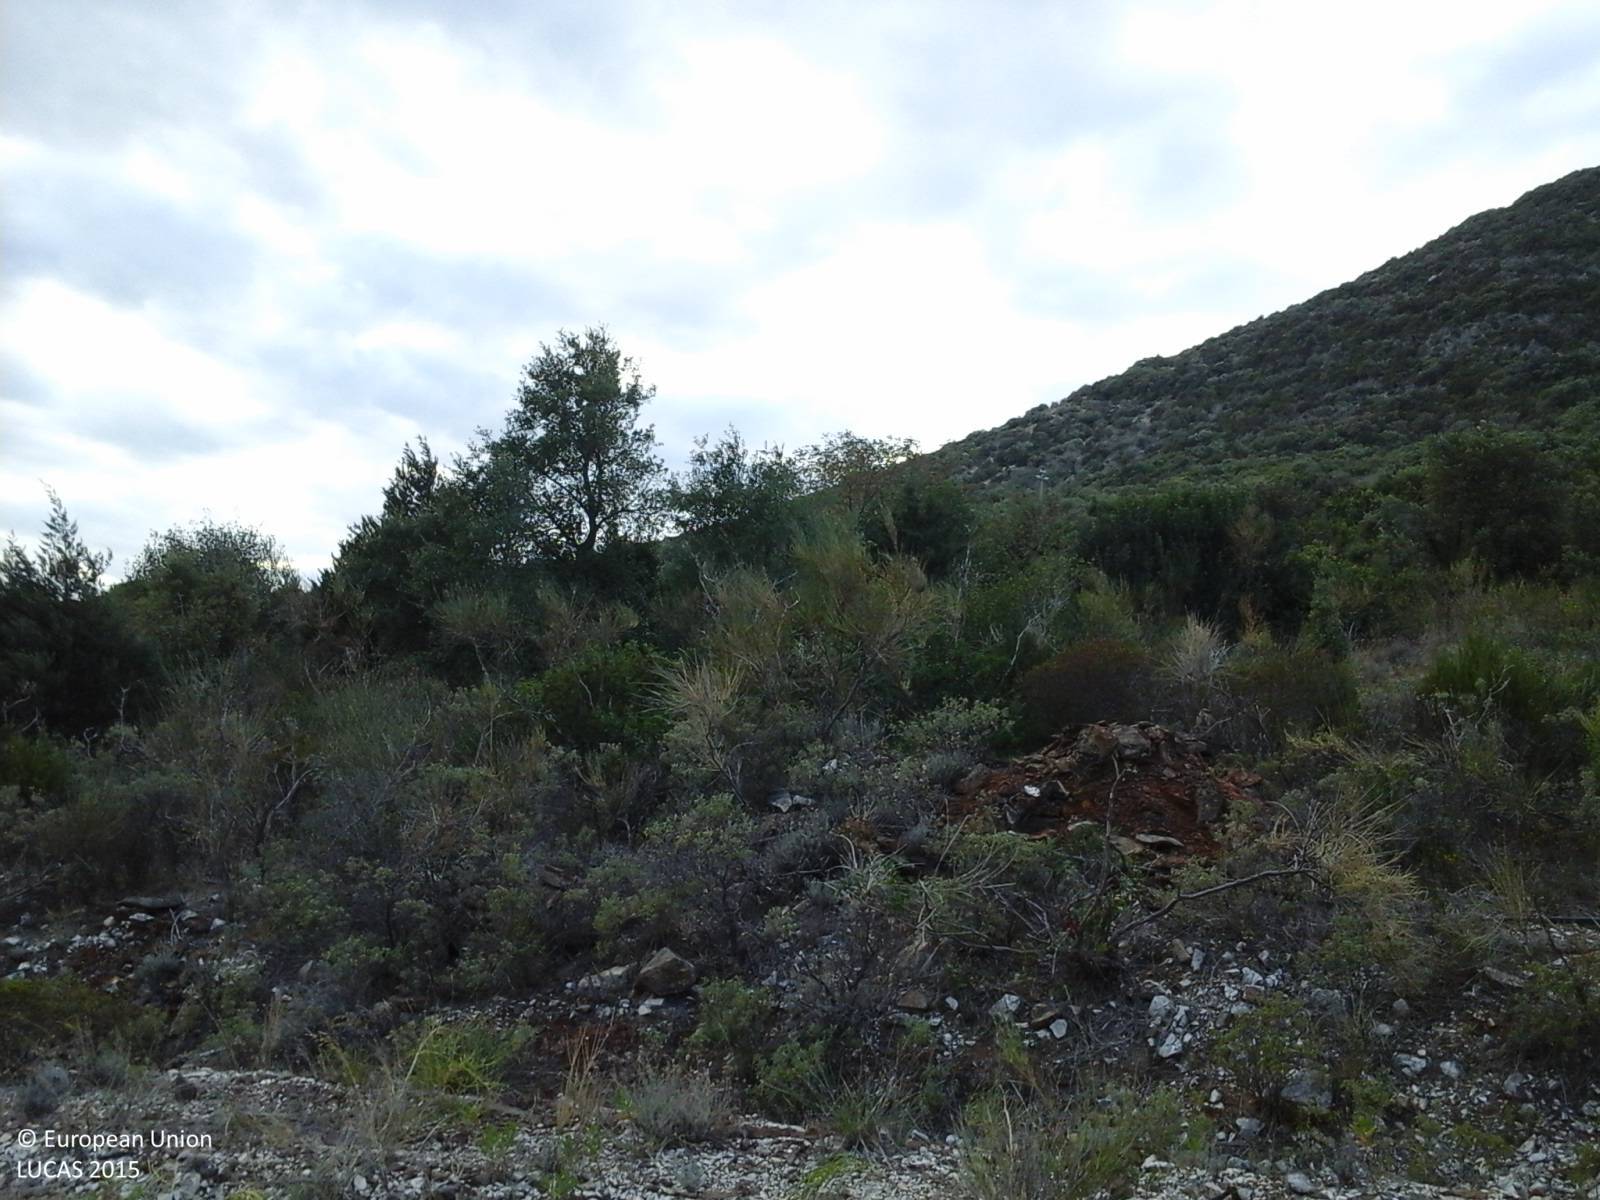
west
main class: Woodland
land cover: Broadleaved woodland
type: thermophilous deciduous forest
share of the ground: > 75 %
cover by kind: broadleaved forest trees 100 %
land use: Forestry
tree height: > 5 m
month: September
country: IT
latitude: 43.0856
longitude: 10.6000
